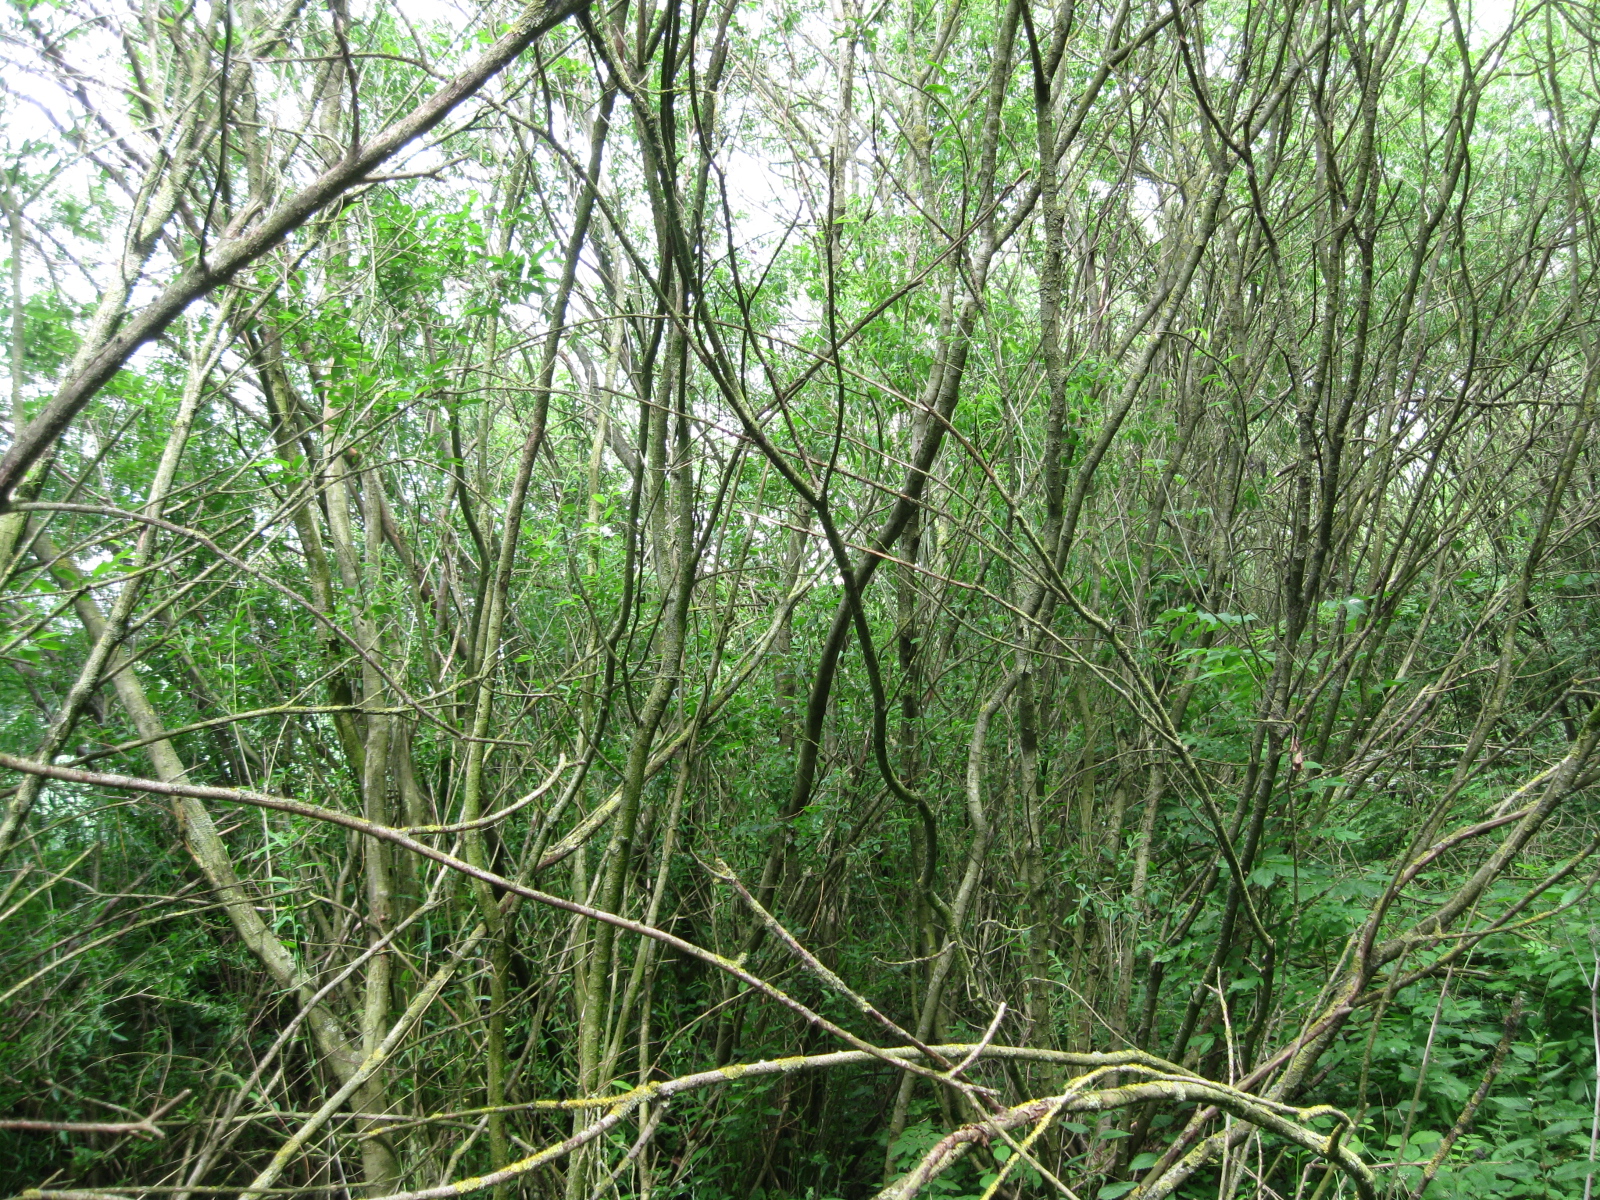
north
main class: Woodland
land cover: Broadleaved woodland
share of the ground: > 75 %
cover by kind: broadleaved forest trees 80 %, herbaceous plants 10 %, coniferous forest trees 5 %, shrubs 5 %
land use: Forestry
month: June
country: LT
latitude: 55.2914
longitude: 24.1235
